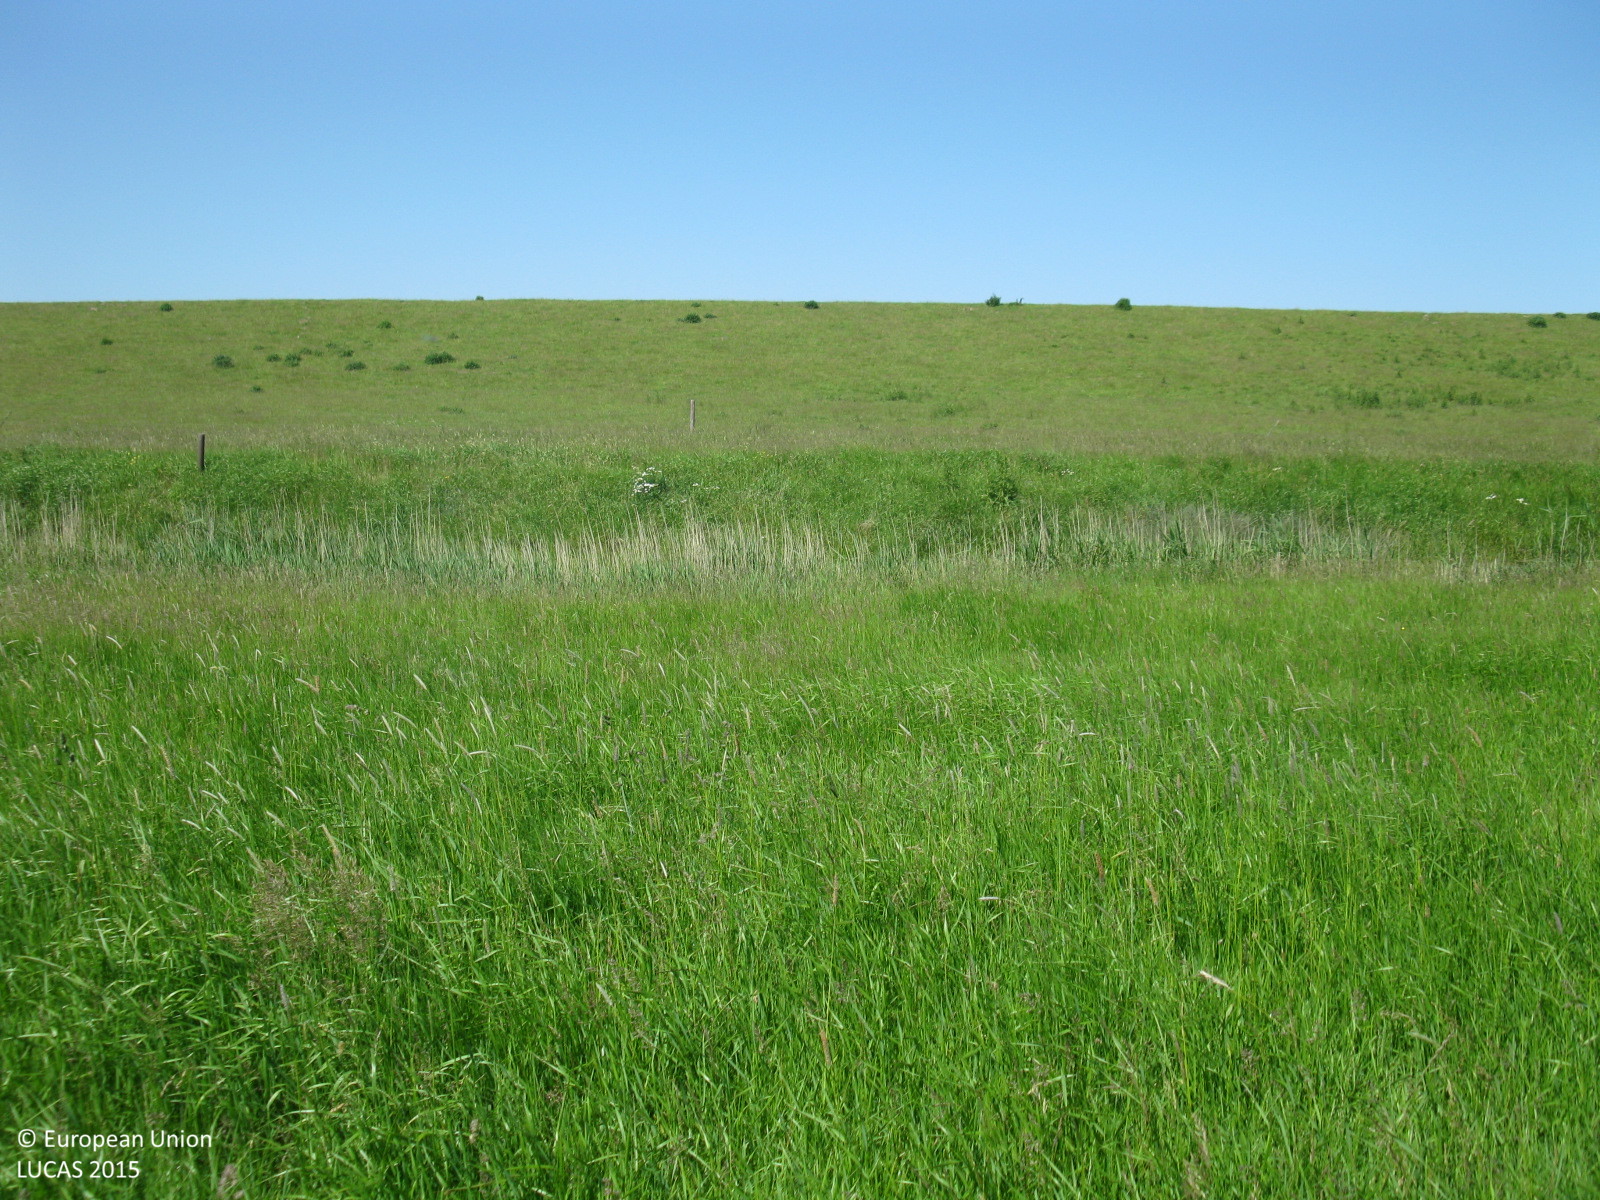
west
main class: Grassland
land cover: Grassland without tree/shrub cover
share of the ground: > 75 %
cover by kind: herbaceous plants 100 %
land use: Agriculture (excluding fallow land and kitchen gardens)
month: June
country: DE
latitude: 53.4982
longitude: 8.3274
